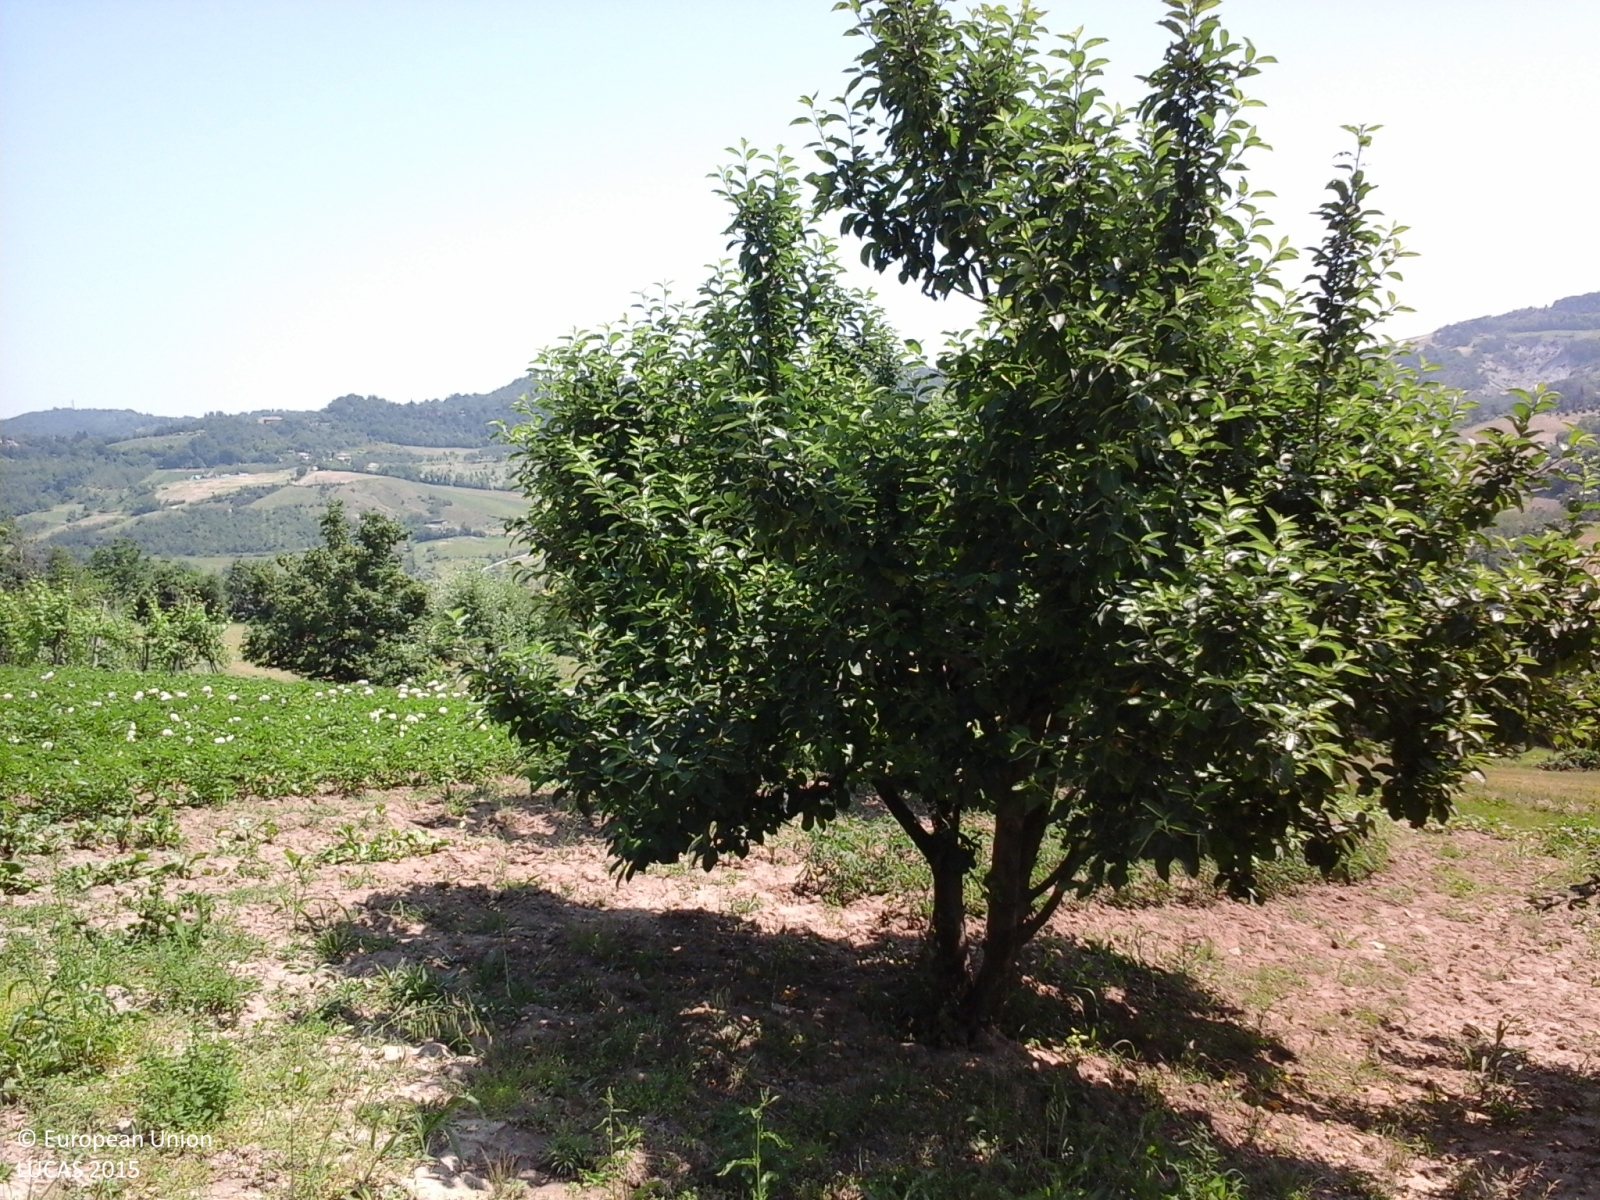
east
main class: Cropland
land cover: Apple fruit
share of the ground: 50 - 75 %
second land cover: Spontaneously vegetated surfaces
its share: 50 - 75 %
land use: Kitchen garden
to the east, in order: Apple fruit; Spontaneously vegetated surfaces; Other fresh vegetables; Grassland without tree/shrub cover; Common wheat; Paved roads, cycling and walking lanes; Managed hedges; Fences; Broadleaved woodland
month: June
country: IT
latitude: 44.4339
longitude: 11.1908
